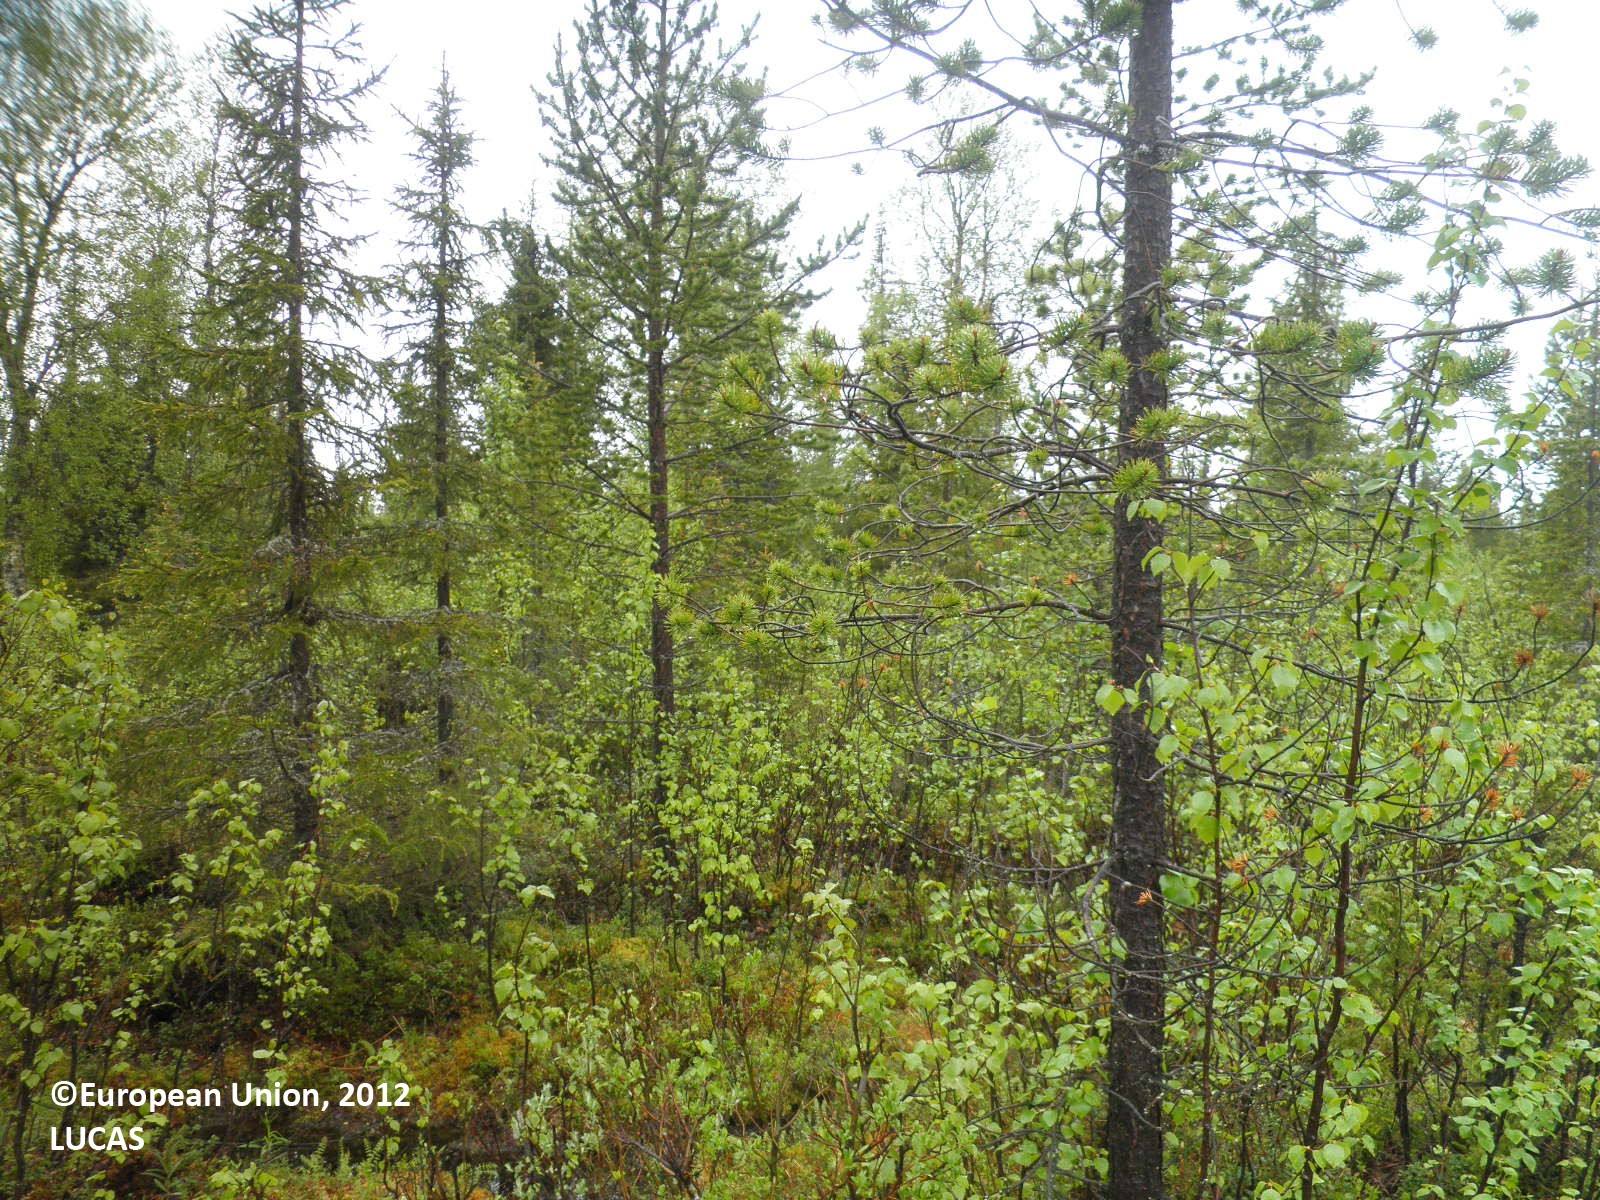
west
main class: Woodland
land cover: Pine dominated mixed woodland
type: boreal forest
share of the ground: 10 - 25 %
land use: Forestry
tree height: > 5 m
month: June
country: FI
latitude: 67.9987
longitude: 25.7617
